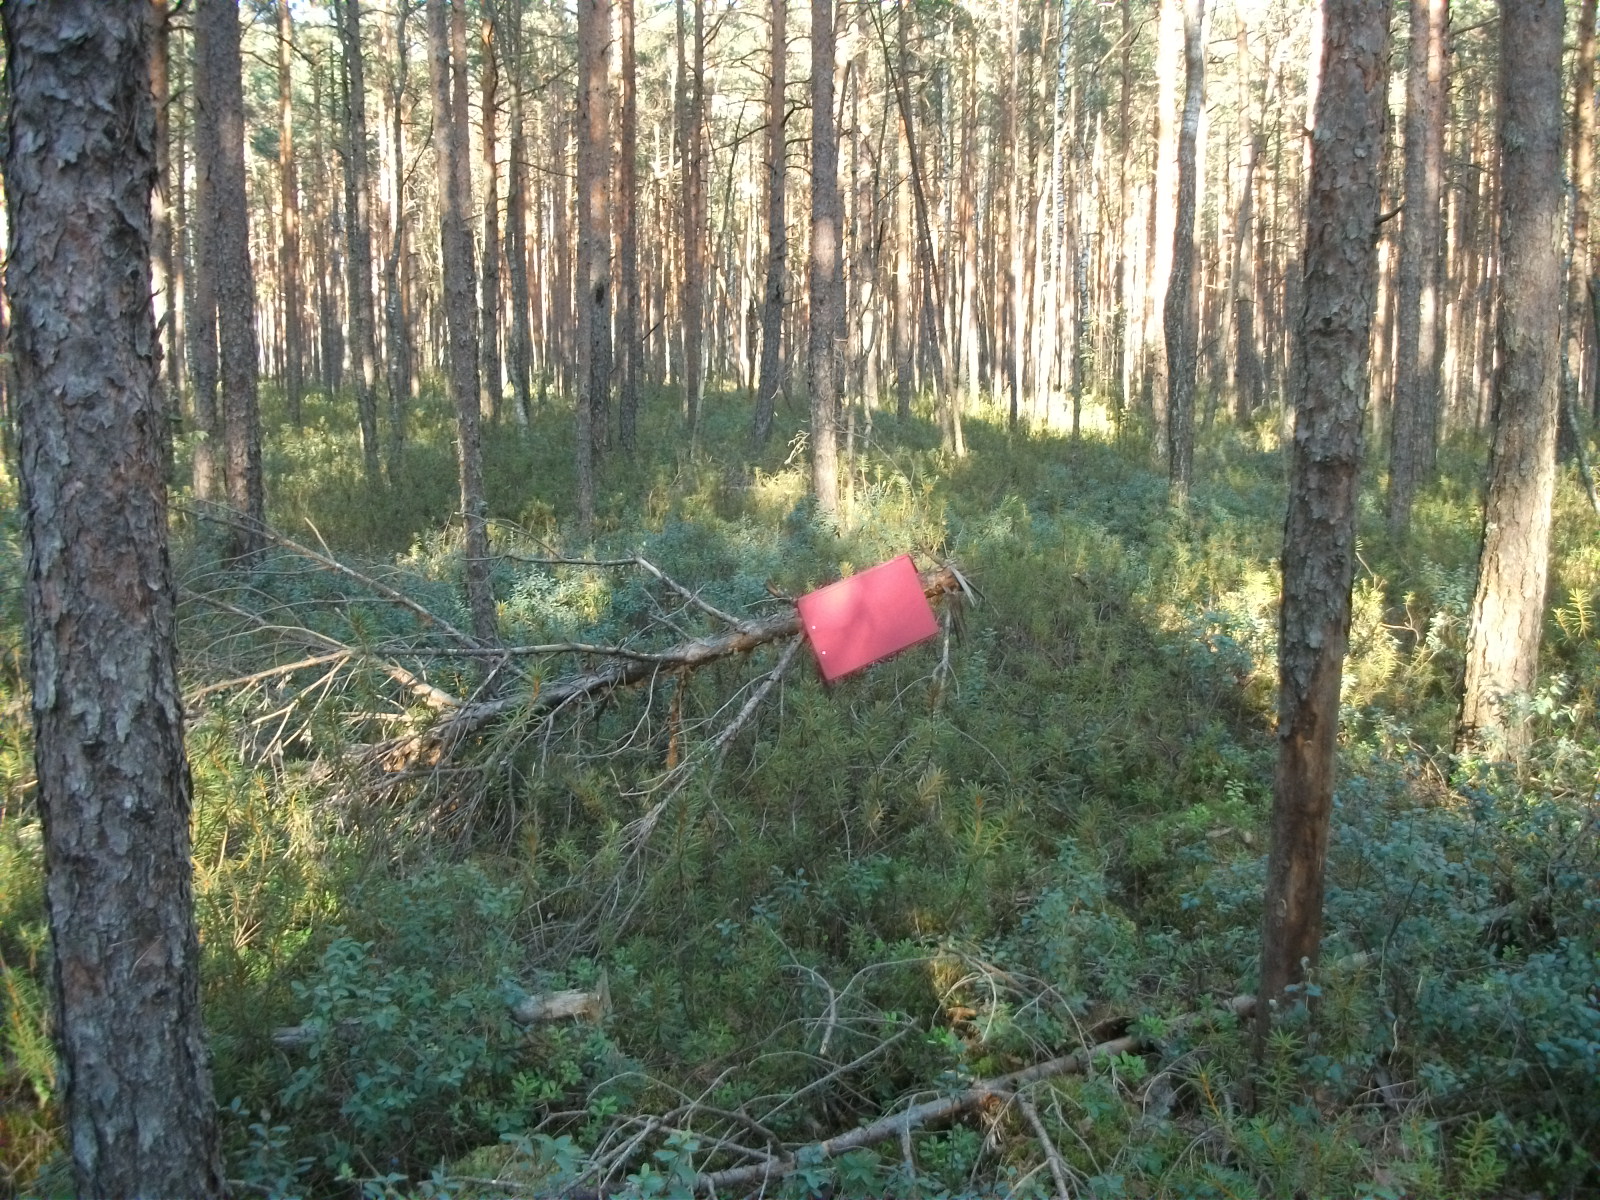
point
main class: Woodland
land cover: Pine dominated coniferous woodland
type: hemiboreal forest and nemoral coniferous forest and mixed broadleaved-coniferous forest
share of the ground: > 75 %
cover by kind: coniferous forest trees 85 %, lichens and mosses 15 %
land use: Forestry
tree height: > 5 m
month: August
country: LV
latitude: 56.5222
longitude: 26.3829
